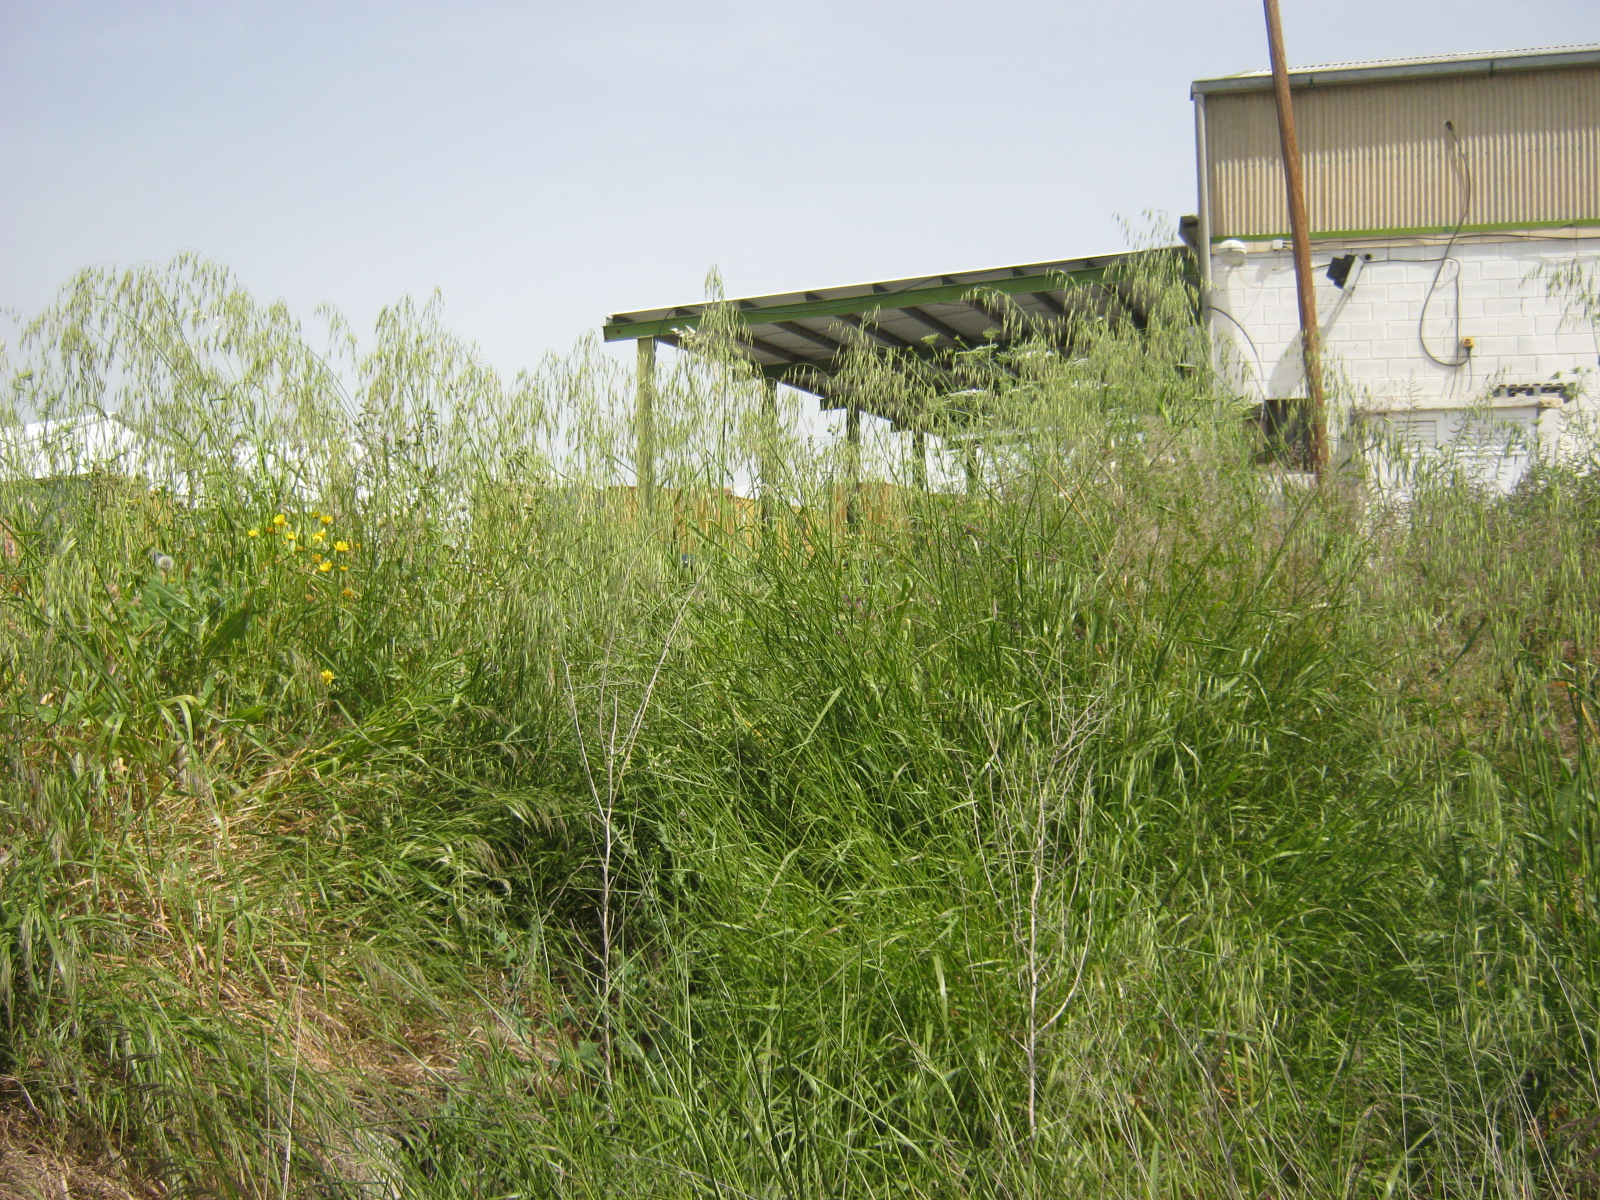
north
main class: Grassland
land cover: Spontaneously vegetated surfaces
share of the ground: > 75 %
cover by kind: herbaceous plants 100 %
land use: Logistics and storage
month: April
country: CY
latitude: 35.0473
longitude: 33.4003
